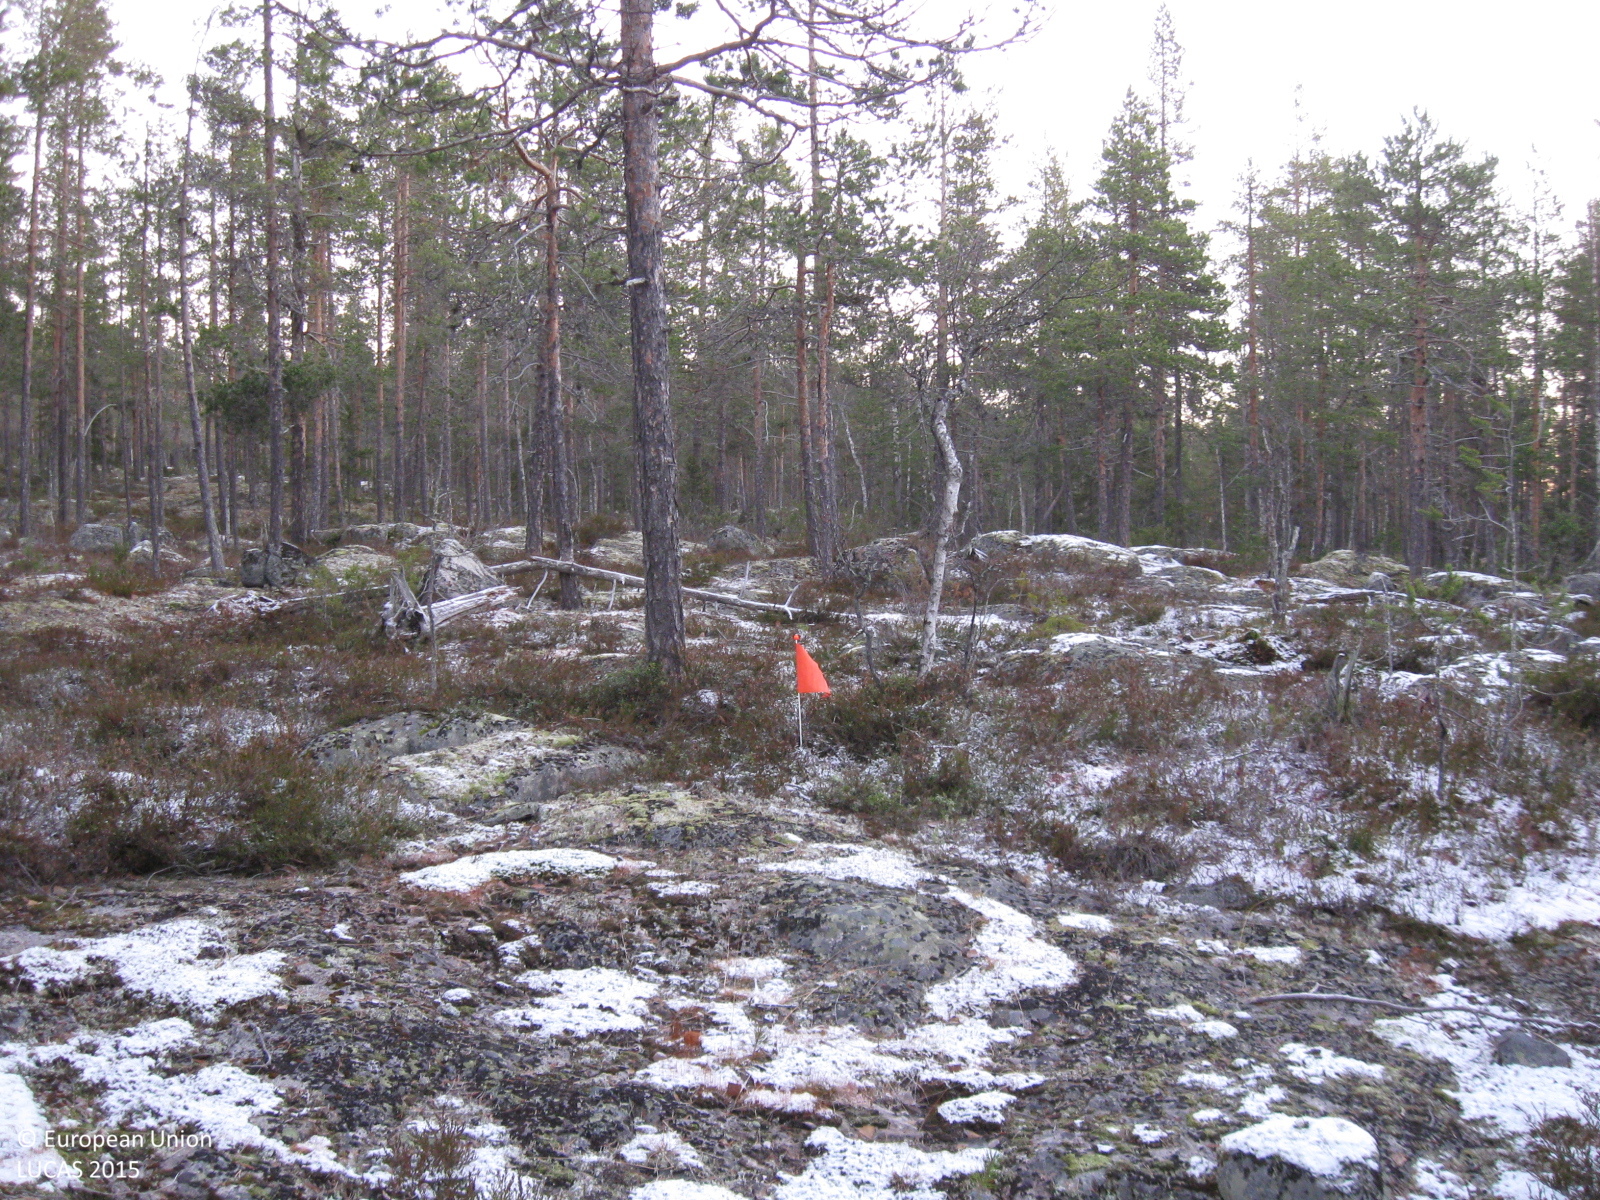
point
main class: Woodland
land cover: Pine dominated coniferous woodland
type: boreal forest
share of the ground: 25 - 50 %
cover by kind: consolidated bare surface 40 %, coniferous forest trees 25 %, shrubs 15 %, lichens and mosses 10 %, broadleaved forest trees 5 %, herbaceous plants 5 %
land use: Forestry
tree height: > 5 m
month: October
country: SE
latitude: 66.1116
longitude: 21.6308
